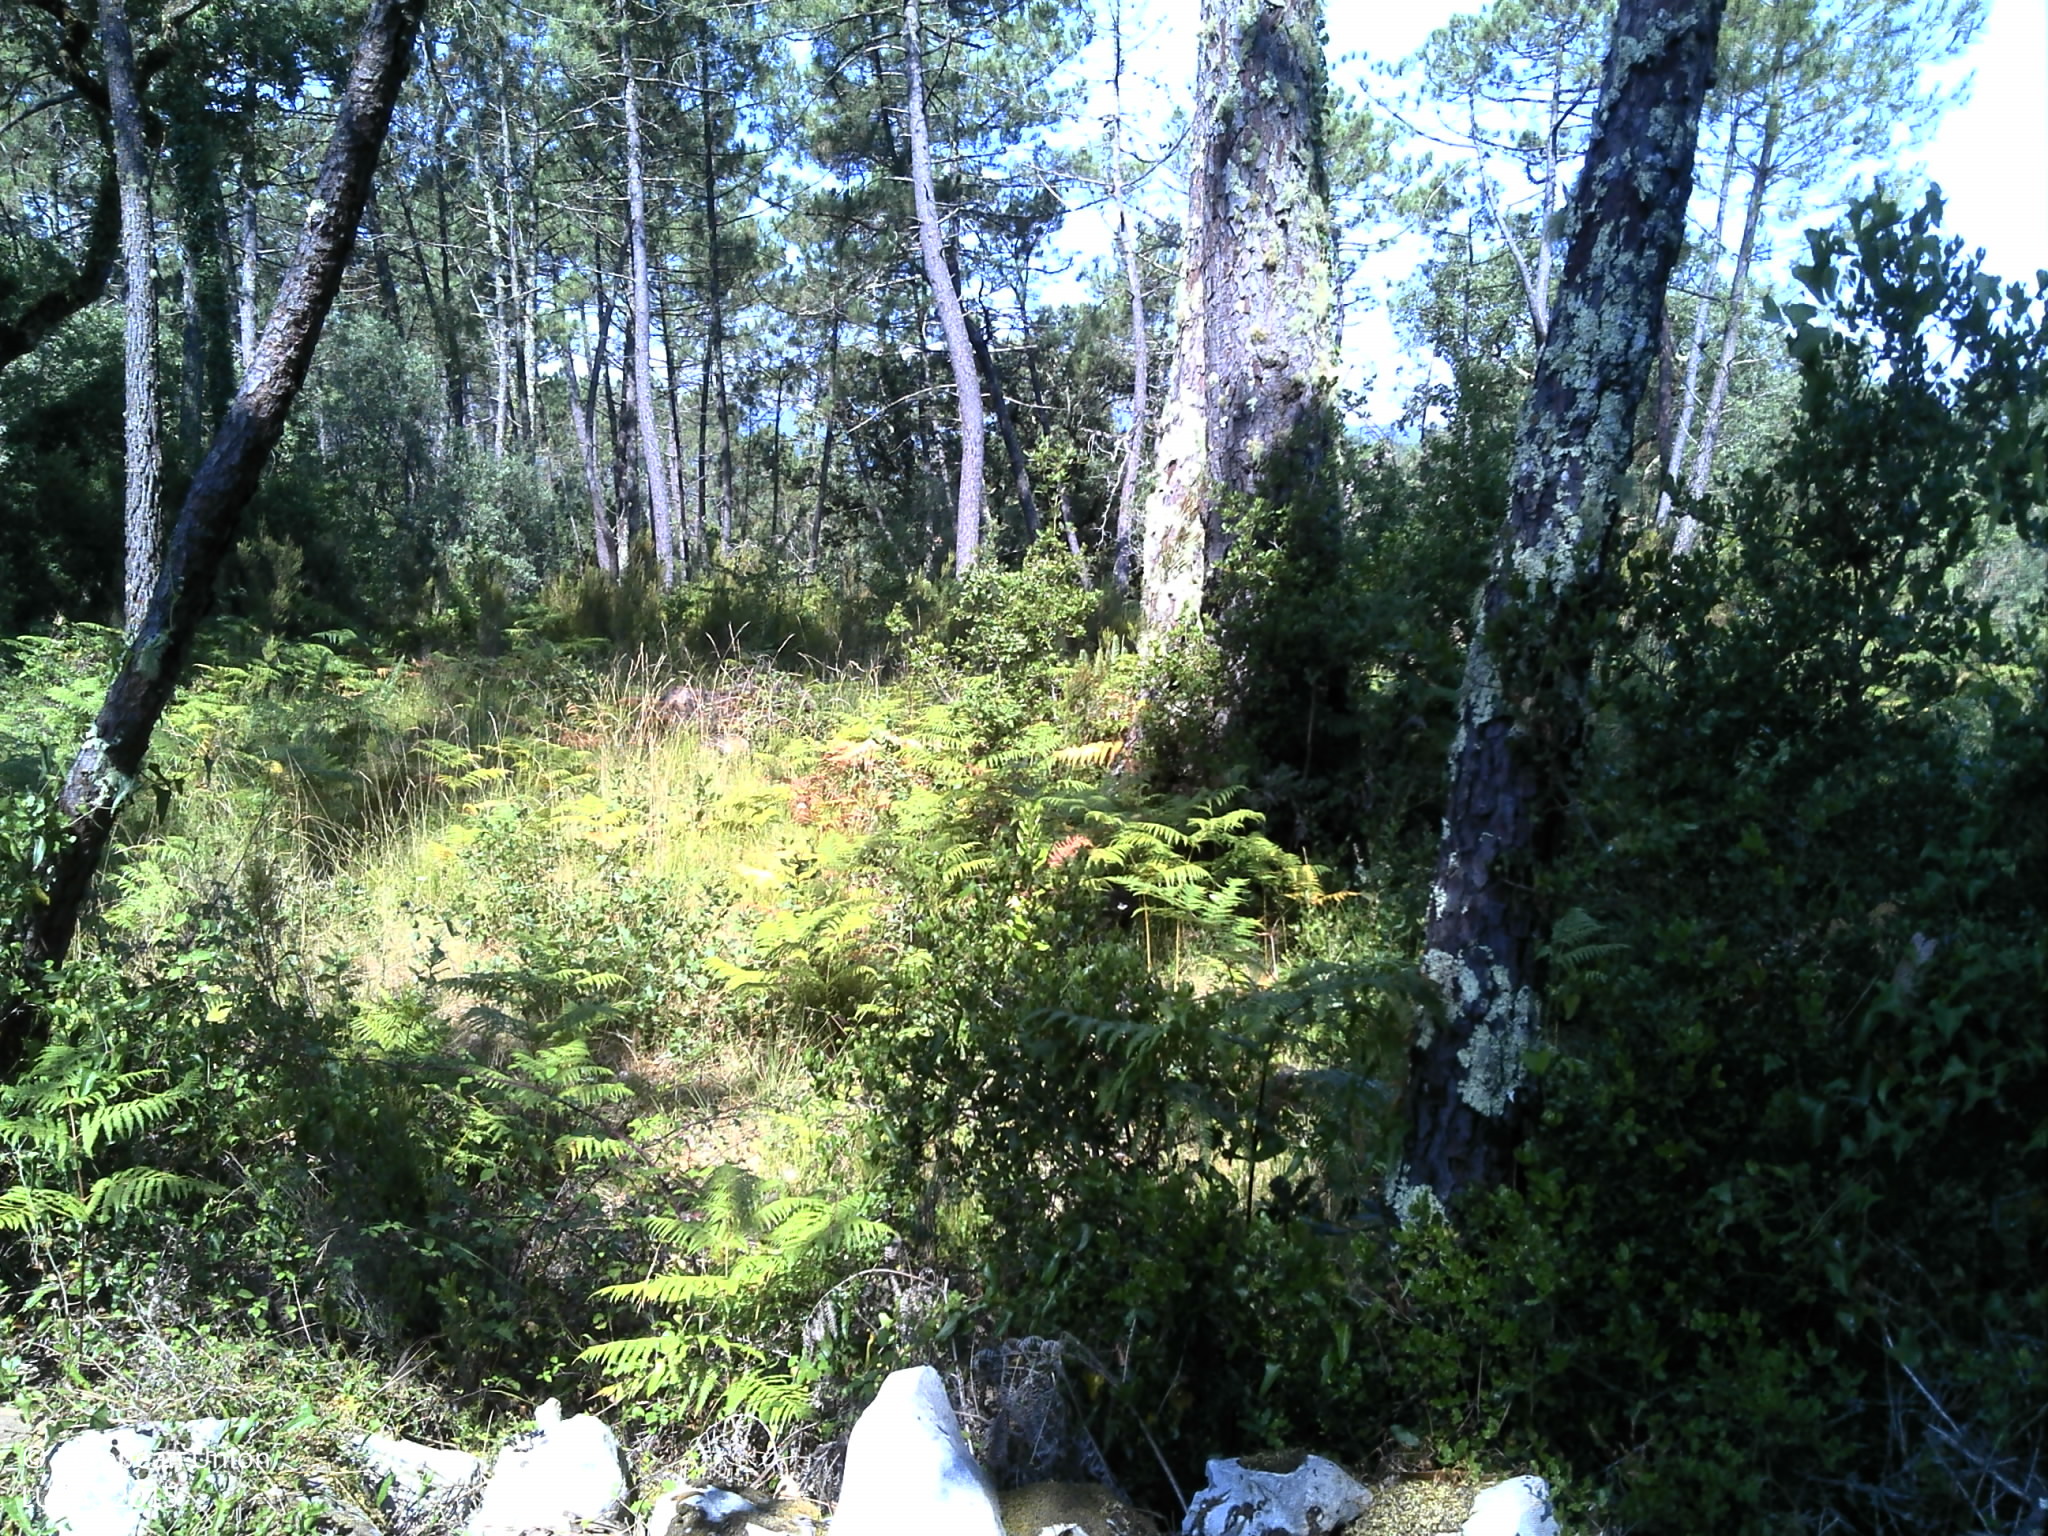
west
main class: Woodland
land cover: Broadleaved woodland
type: exotic forest
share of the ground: 50 - 75 %
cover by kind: broadleaved forest trees 55 %, unconsolidated bare surface 40 %, shrubs 5 %
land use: Forestry
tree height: > 5 m
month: July
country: PT
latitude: 39.9403
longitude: -8.4653
